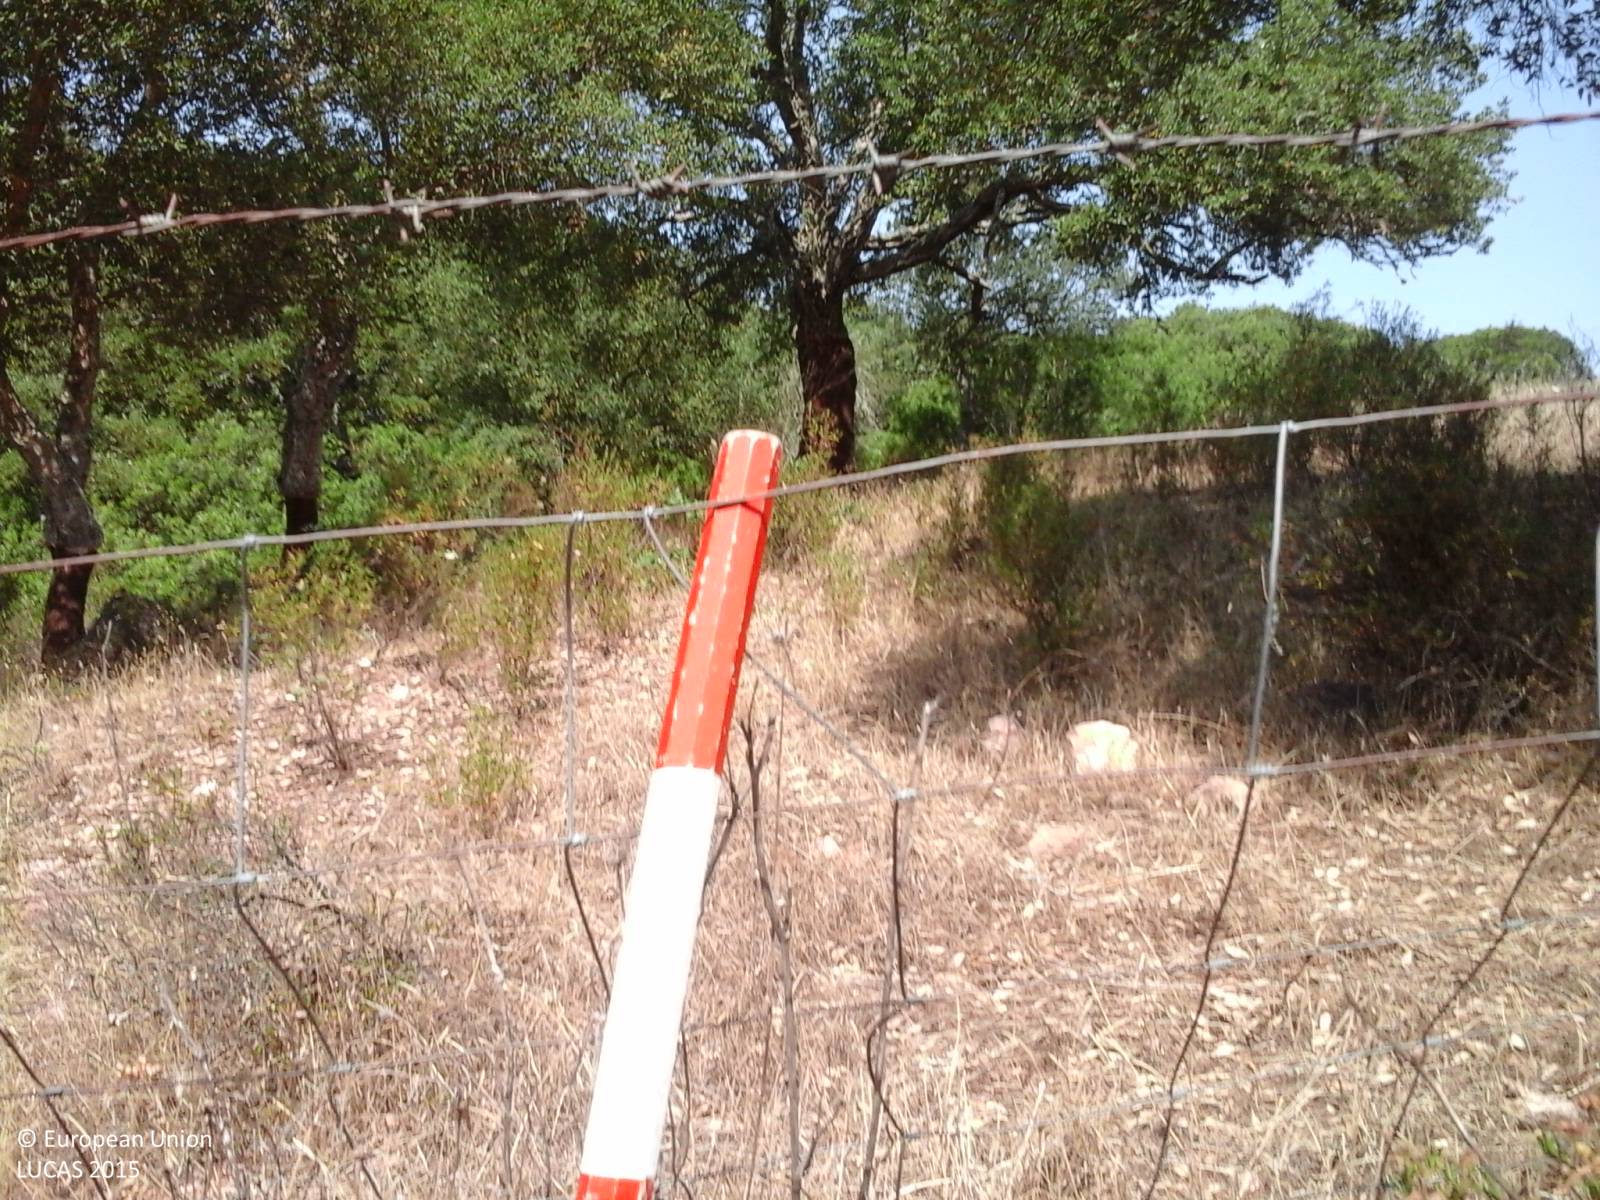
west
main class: Woodland
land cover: Broadleaved woodland
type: broadleaved evergreen forest
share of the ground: > 75 %
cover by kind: broadleaved forest trees 100 %
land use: Forestry
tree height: < 5 m
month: July
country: IT
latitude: 39.9349
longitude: 8.8711
